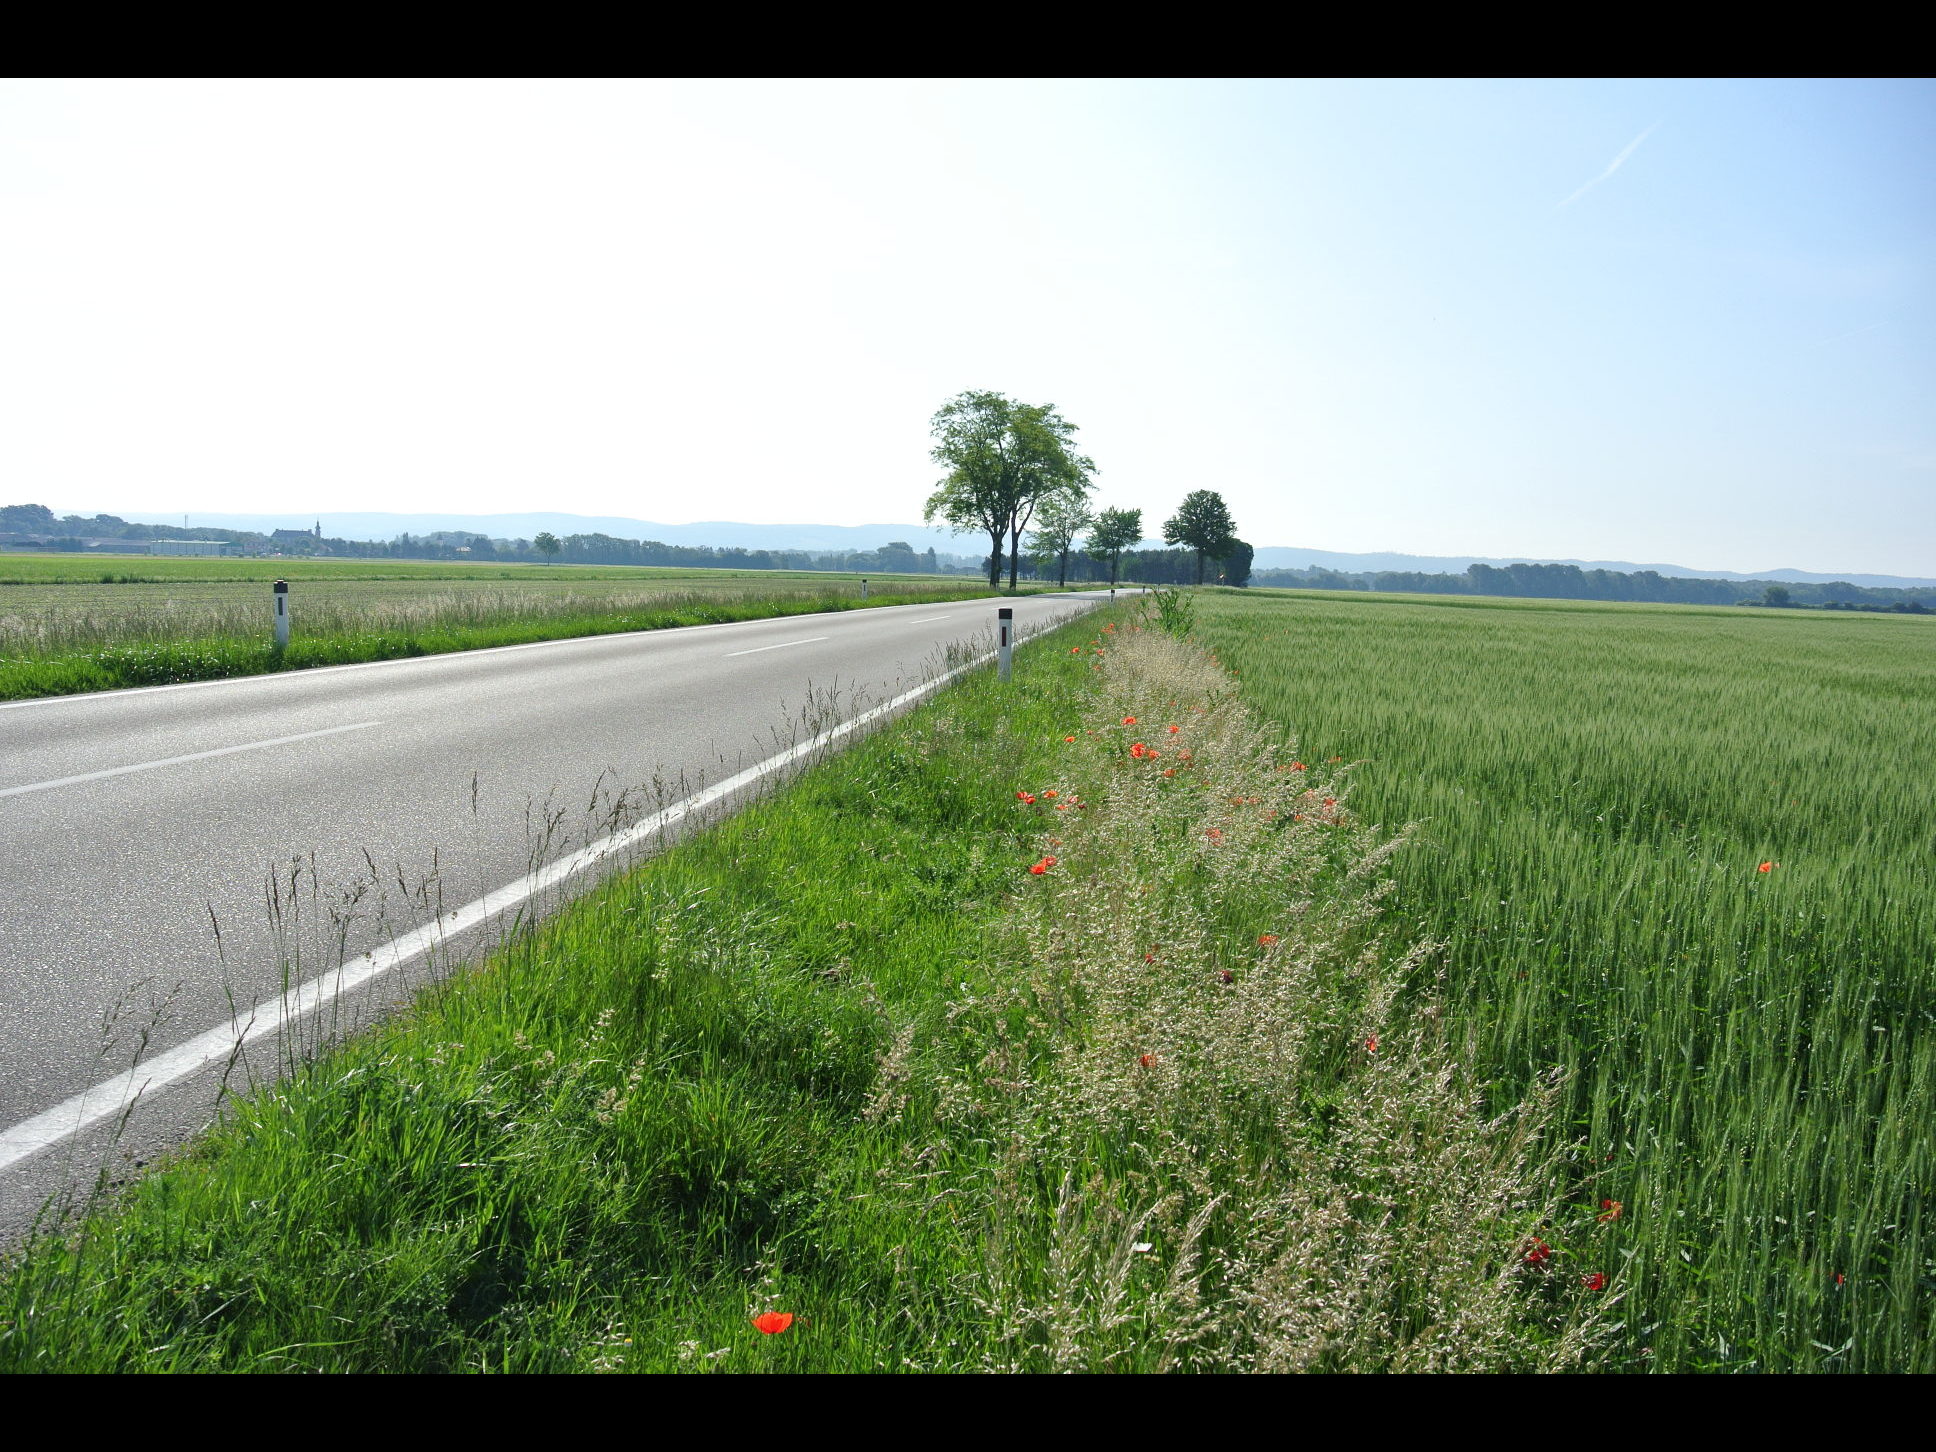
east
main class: Cropland
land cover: Common wheat
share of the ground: > 75 %
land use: Agriculture (excluding fallow land and kitchen gardens)
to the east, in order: Common wheat; Grass margins; Paved roads, cycling and walking lanes; Grass margins; Other bare soil; Grass margins; Triticale
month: May
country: AT
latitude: 47.9595
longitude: 16.5001
